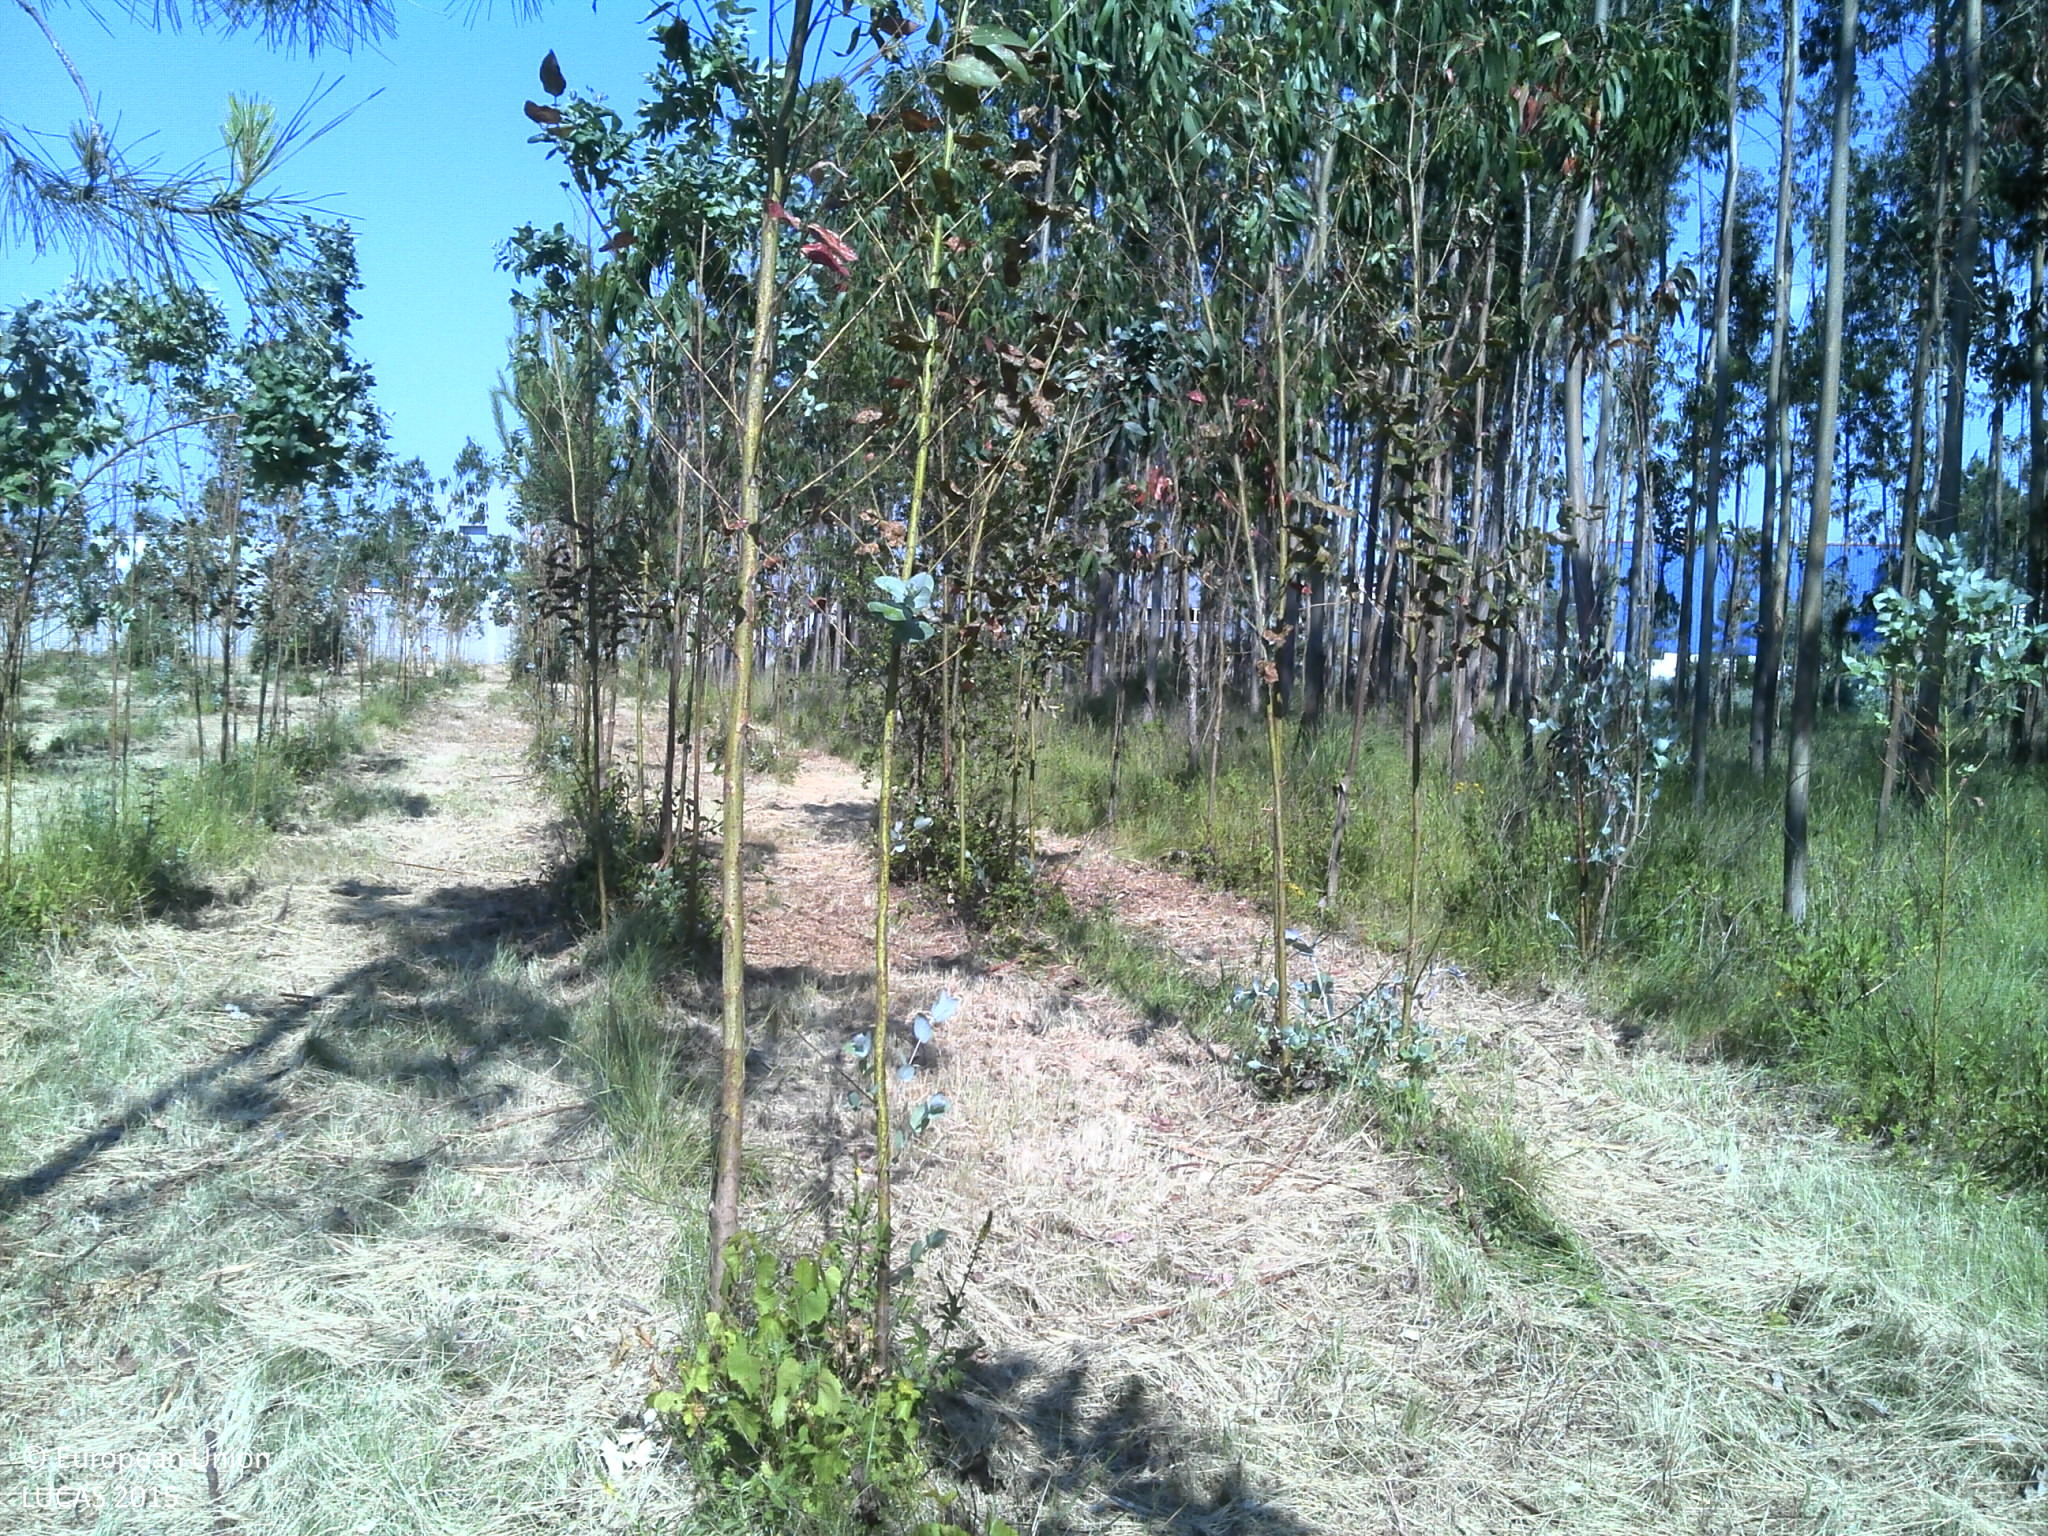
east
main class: Woodland
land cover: Broadleaved woodland
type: exotic forest
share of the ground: 25 - 50 %
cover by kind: broadleaved forest trees 50 %, unconsolidated bare surface 35 %, herbaceous plants 10 %, shrubs 5 %
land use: Forestry
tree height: < 5 m
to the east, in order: Broadleaved woodland; Ditches and canals; Broadleaved woodland; Tracks; Artificial constructions in urban areas
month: June
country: PT
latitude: 40.3558
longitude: -8.6129
